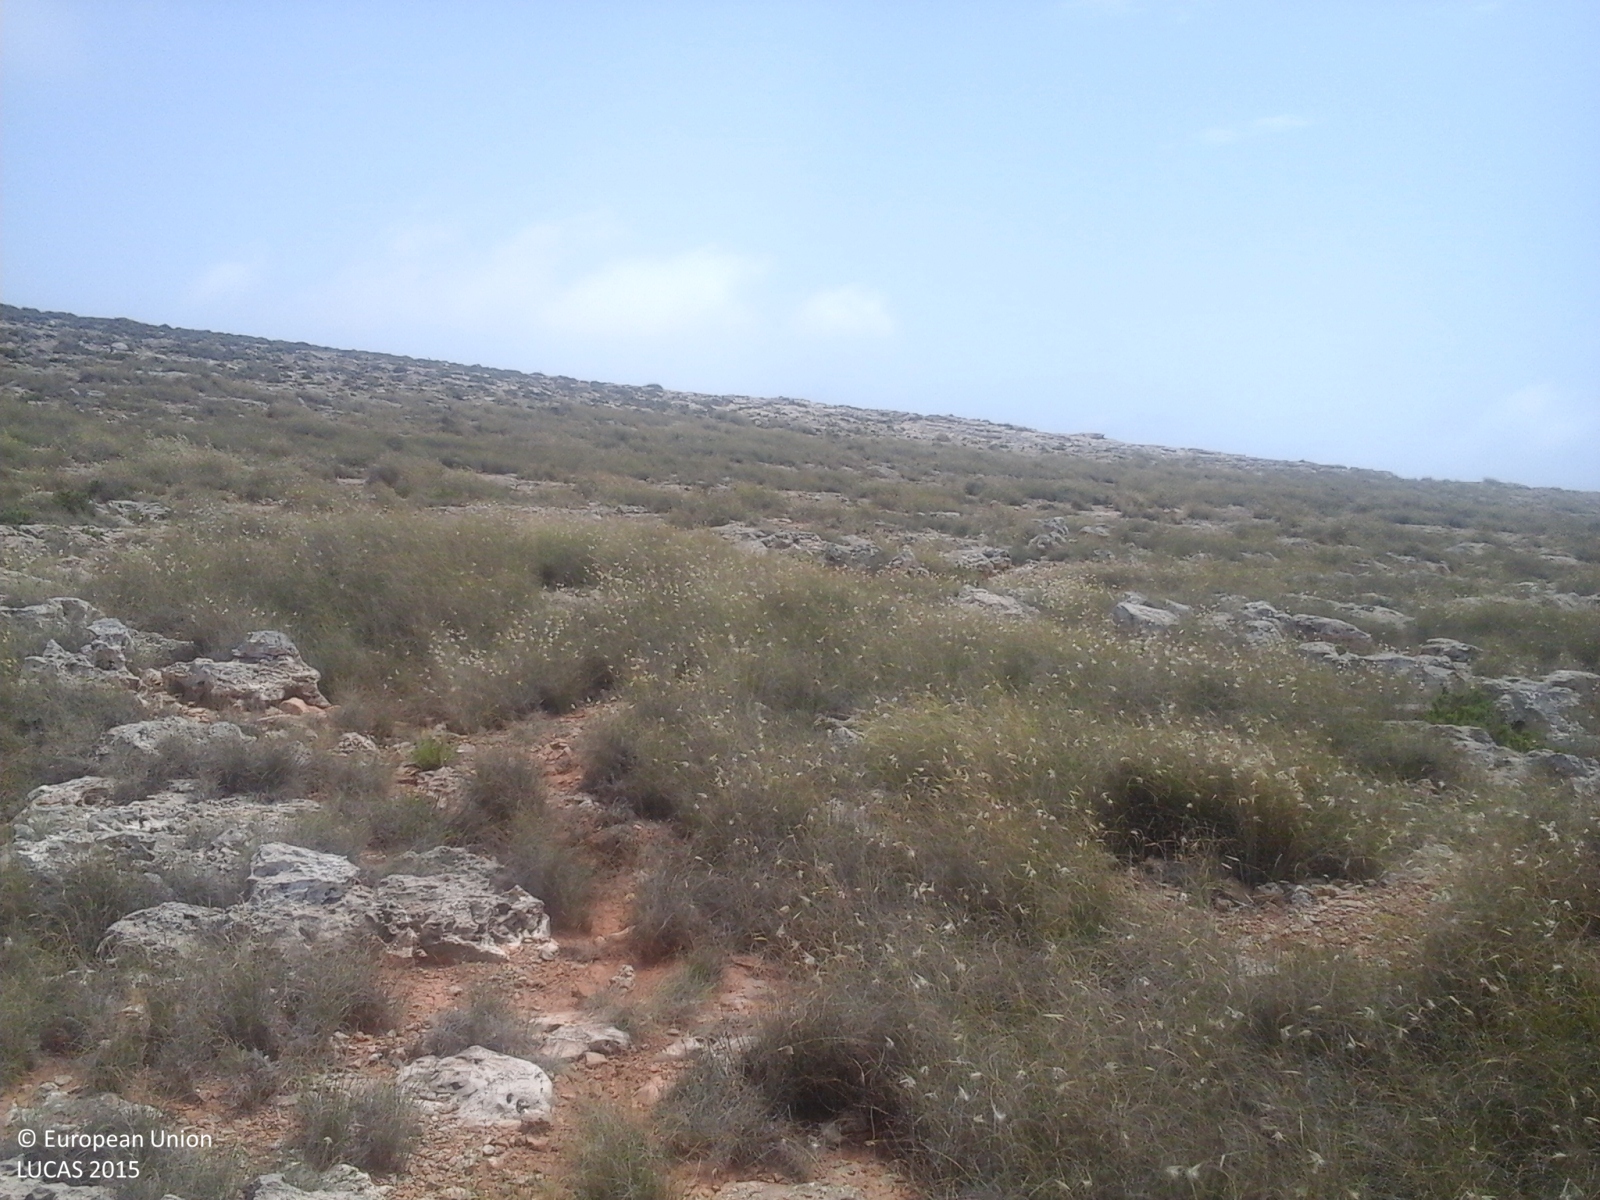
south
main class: Grassland
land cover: Grassland without tree/shrub cover
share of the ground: > 75 %
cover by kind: consolidated bare surface 65 %, herbaceous plants 35 %
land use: Semi-natural and natural areas not in use
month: May
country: MT
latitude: 35.9563
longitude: 14.3396
